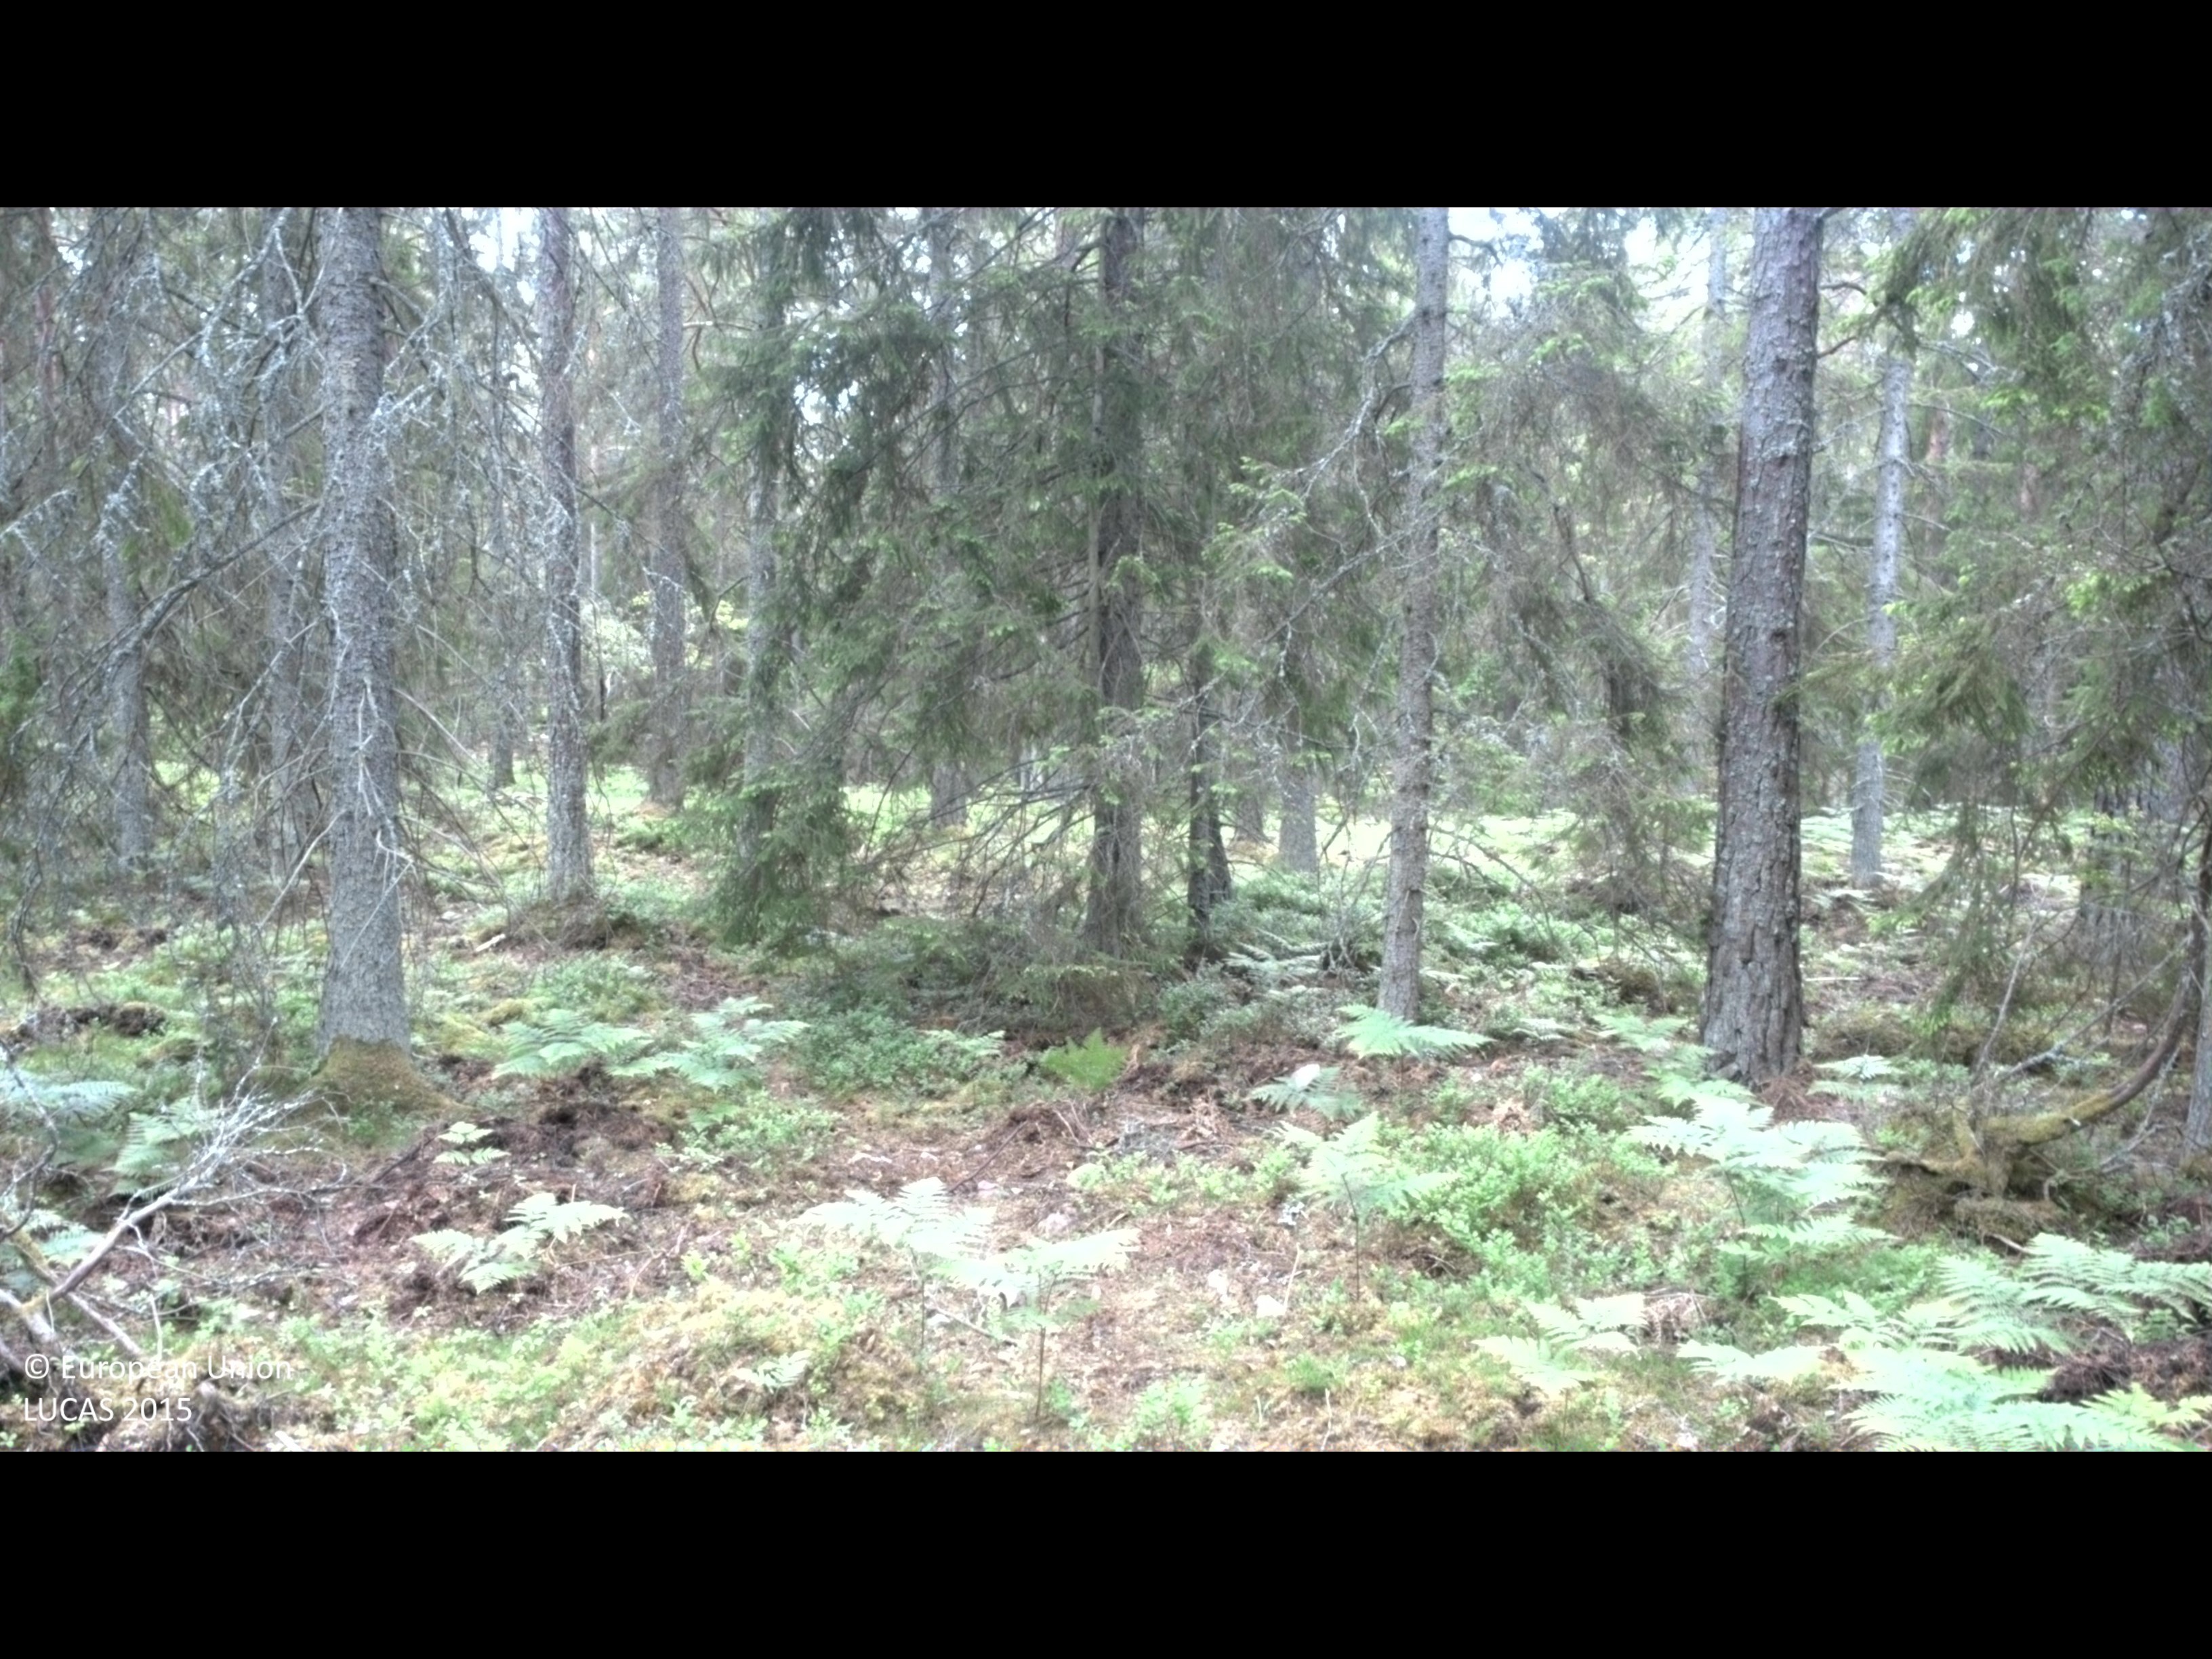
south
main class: Woodland
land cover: Spruce dominated coniferous woodland
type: boreal forest
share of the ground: > 75 %
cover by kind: coniferous forest trees 75 %, shrubs 15 %, herbaceous plants 5 %, lichens and mosses 5 %
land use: Forestry
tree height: > 5 m
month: June
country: SE
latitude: 57.9326
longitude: 16.5674
